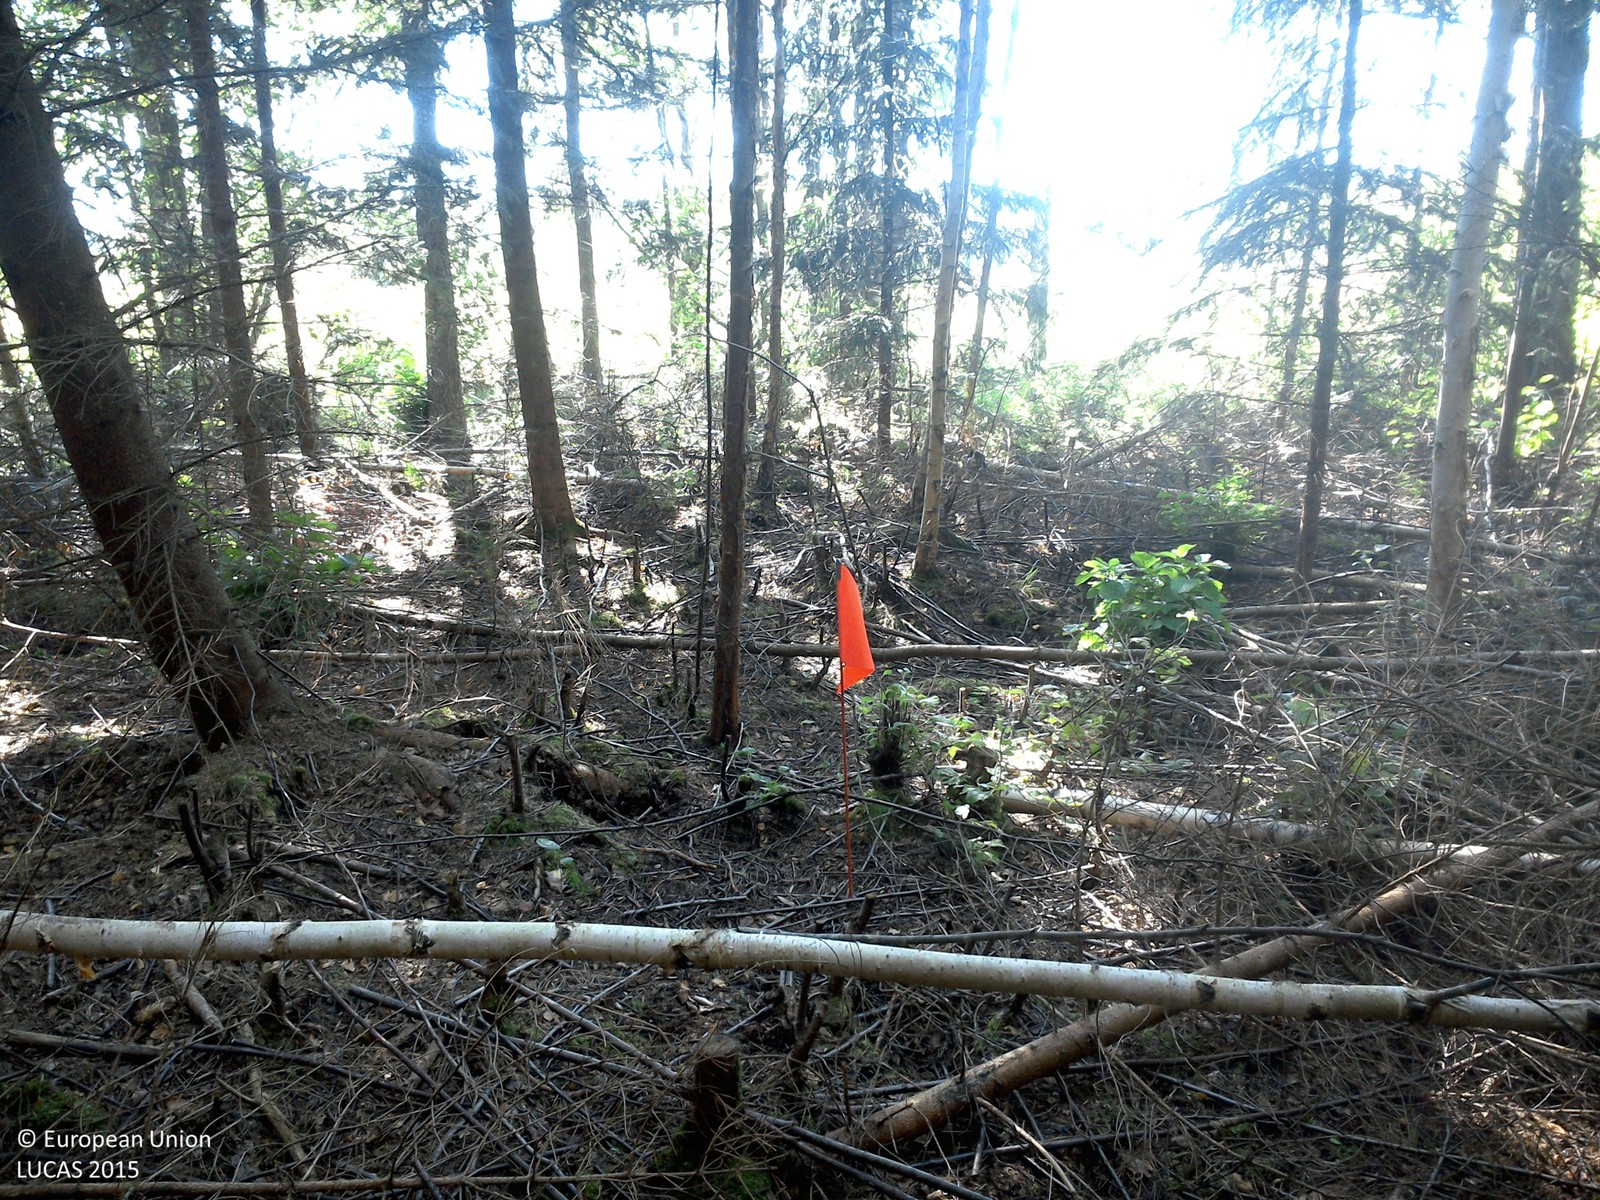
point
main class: Woodland
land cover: Spruce dominated mixed woodland
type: boreal forest
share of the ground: > 75 %
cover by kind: coniferous forest trees 55 %, broadleaved forest trees 20 %, lichens and mosses 15 %, herbaceous plants 10 %
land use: Forestry
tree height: > 5 m
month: August
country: SE
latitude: 57.9673
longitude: 15.3878
